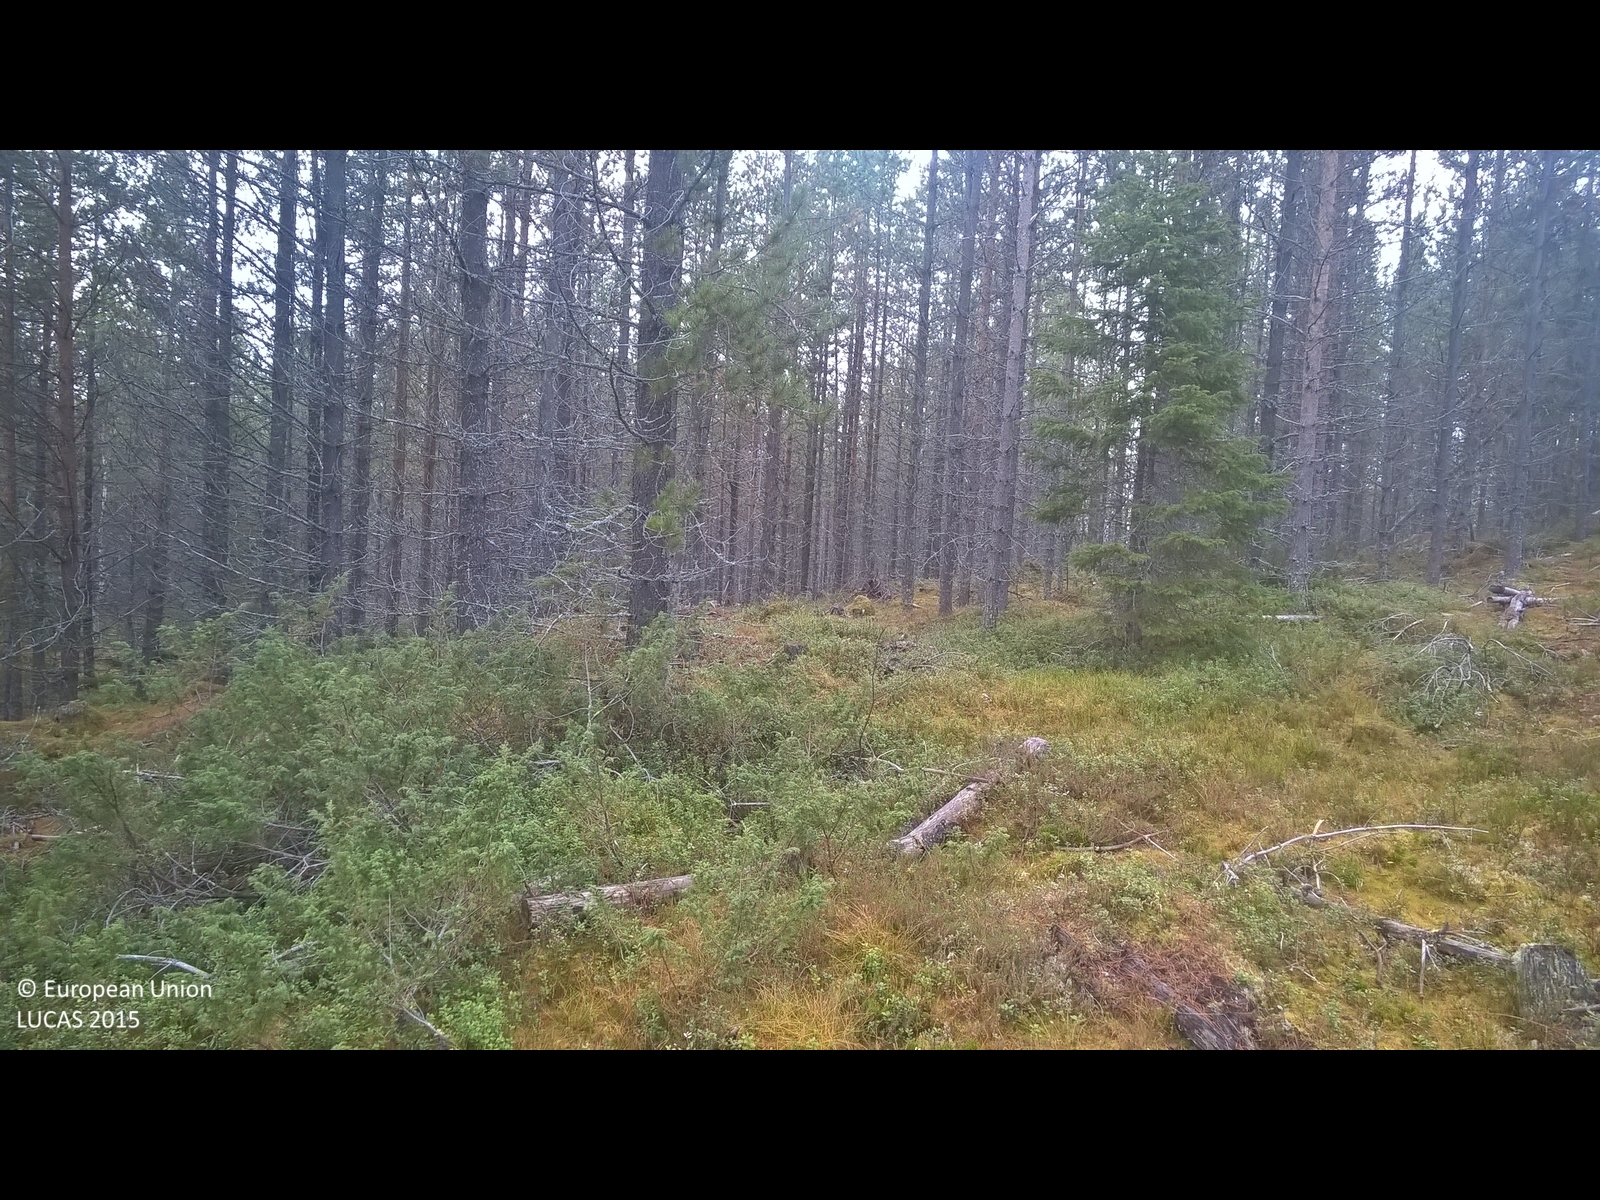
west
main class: Shrubland
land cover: Shrubland without tree cover
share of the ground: > 75 %
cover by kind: shrubs 50 %, herbaceous plants 50 %
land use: Electricity, gas and thermal power distribution
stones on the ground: < 10 %
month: October
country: SE
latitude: 65.2011
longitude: 17.8893
